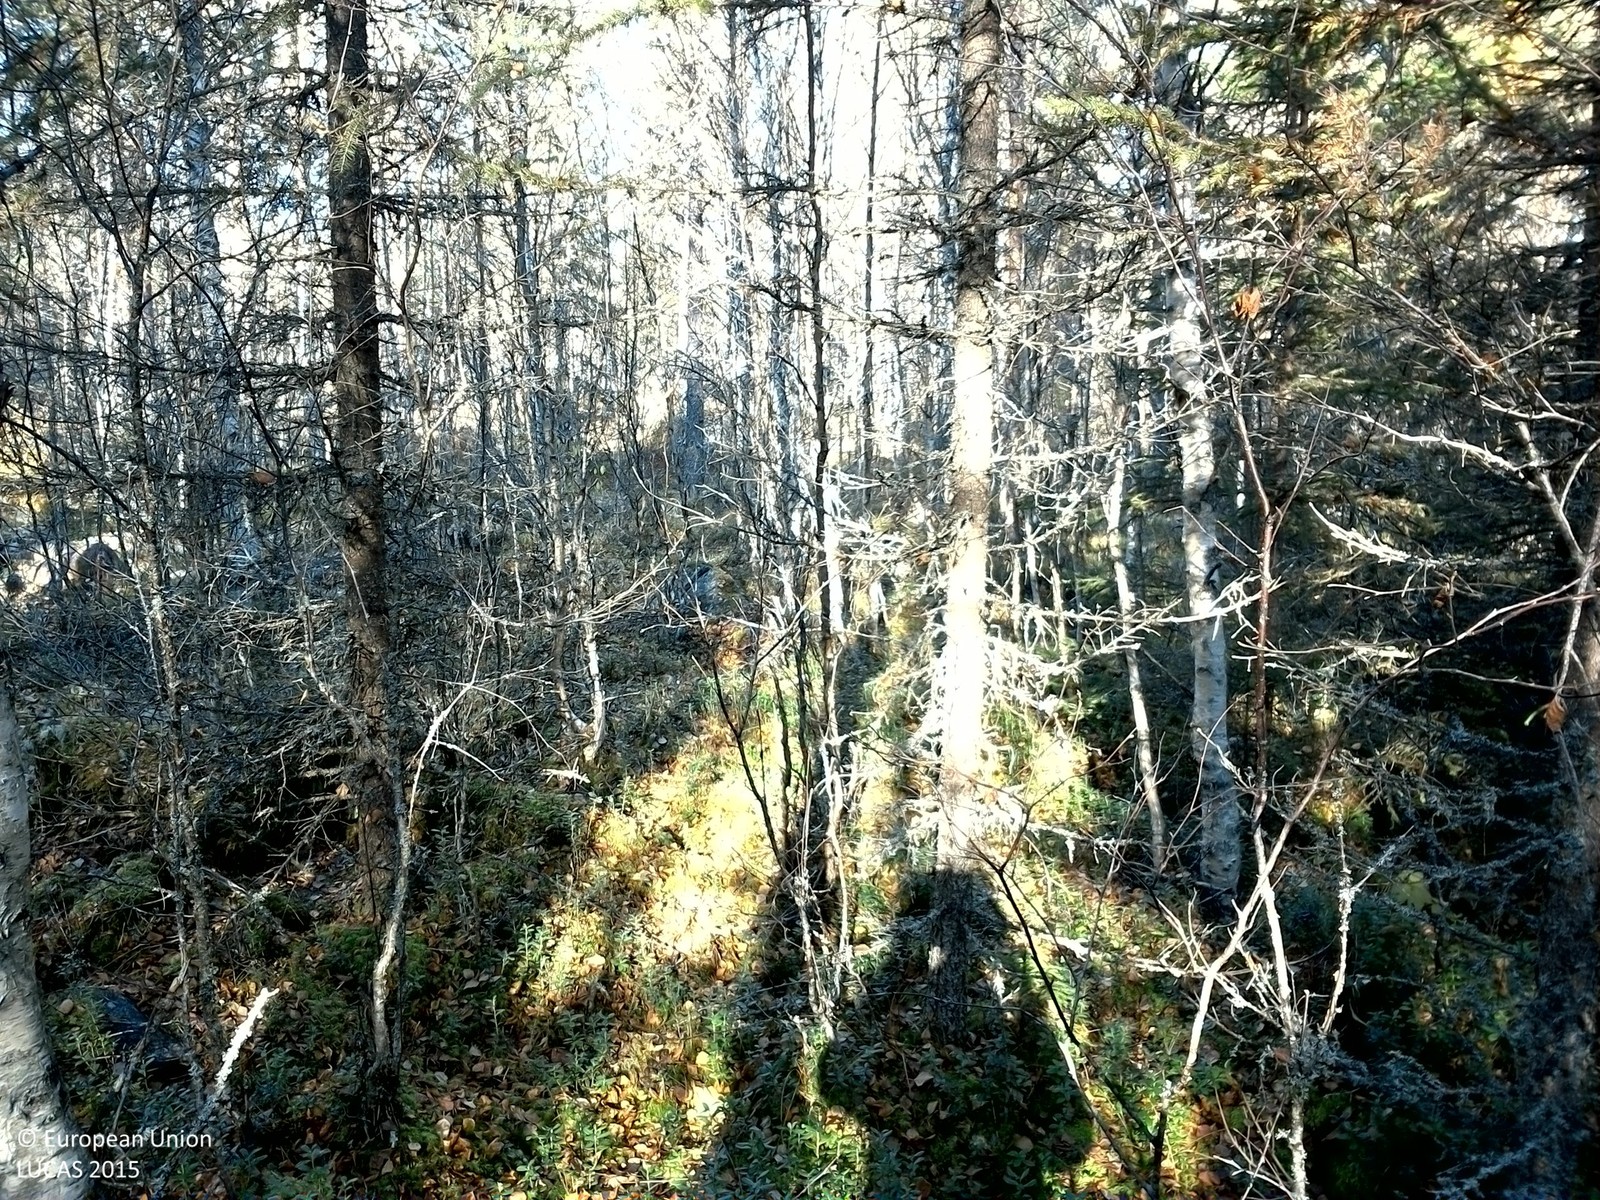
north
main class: Woodland
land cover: Spruce dominated mixed woodland
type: boreal forest
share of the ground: > 75 %
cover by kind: broadleaved forest trees 40 %, coniferous forest trees 35 %, shrubs 15 %, lichens and mosses 10 %
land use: Forestry
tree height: > 5 m
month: October
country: SE
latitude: 61.2112
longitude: 14.9927
